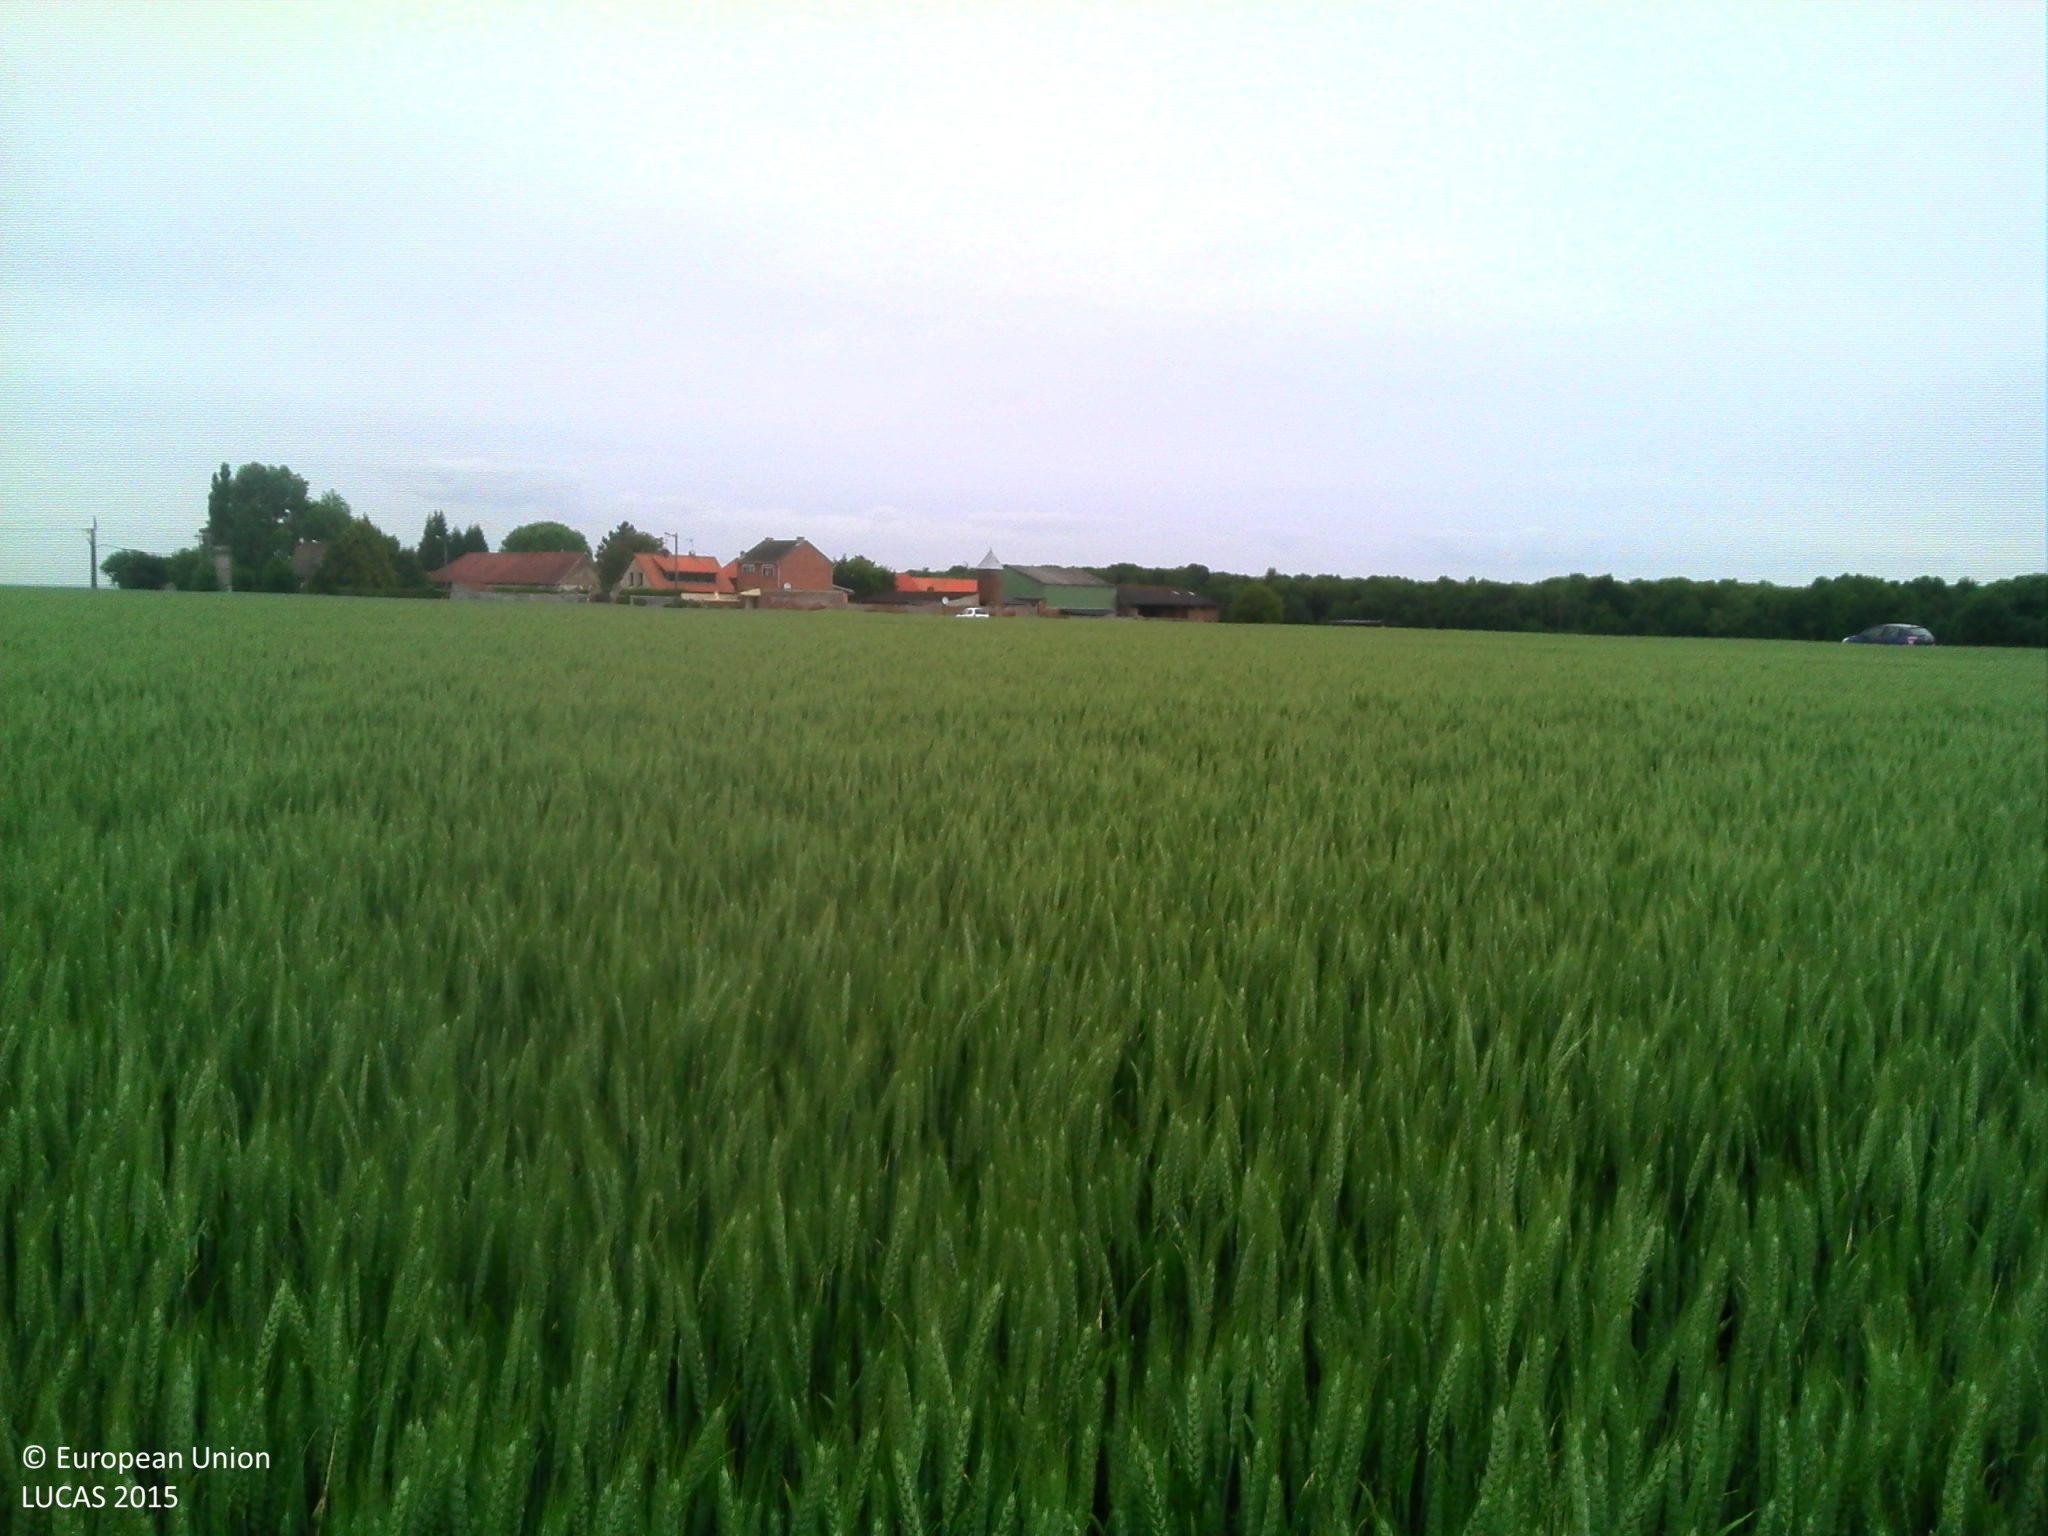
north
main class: Cropland
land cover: Durum wheat
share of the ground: > 75 %
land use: Agriculture (excluding fallow land and kitchen gardens)
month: June
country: FR
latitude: 49.8971
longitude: 2.1759
